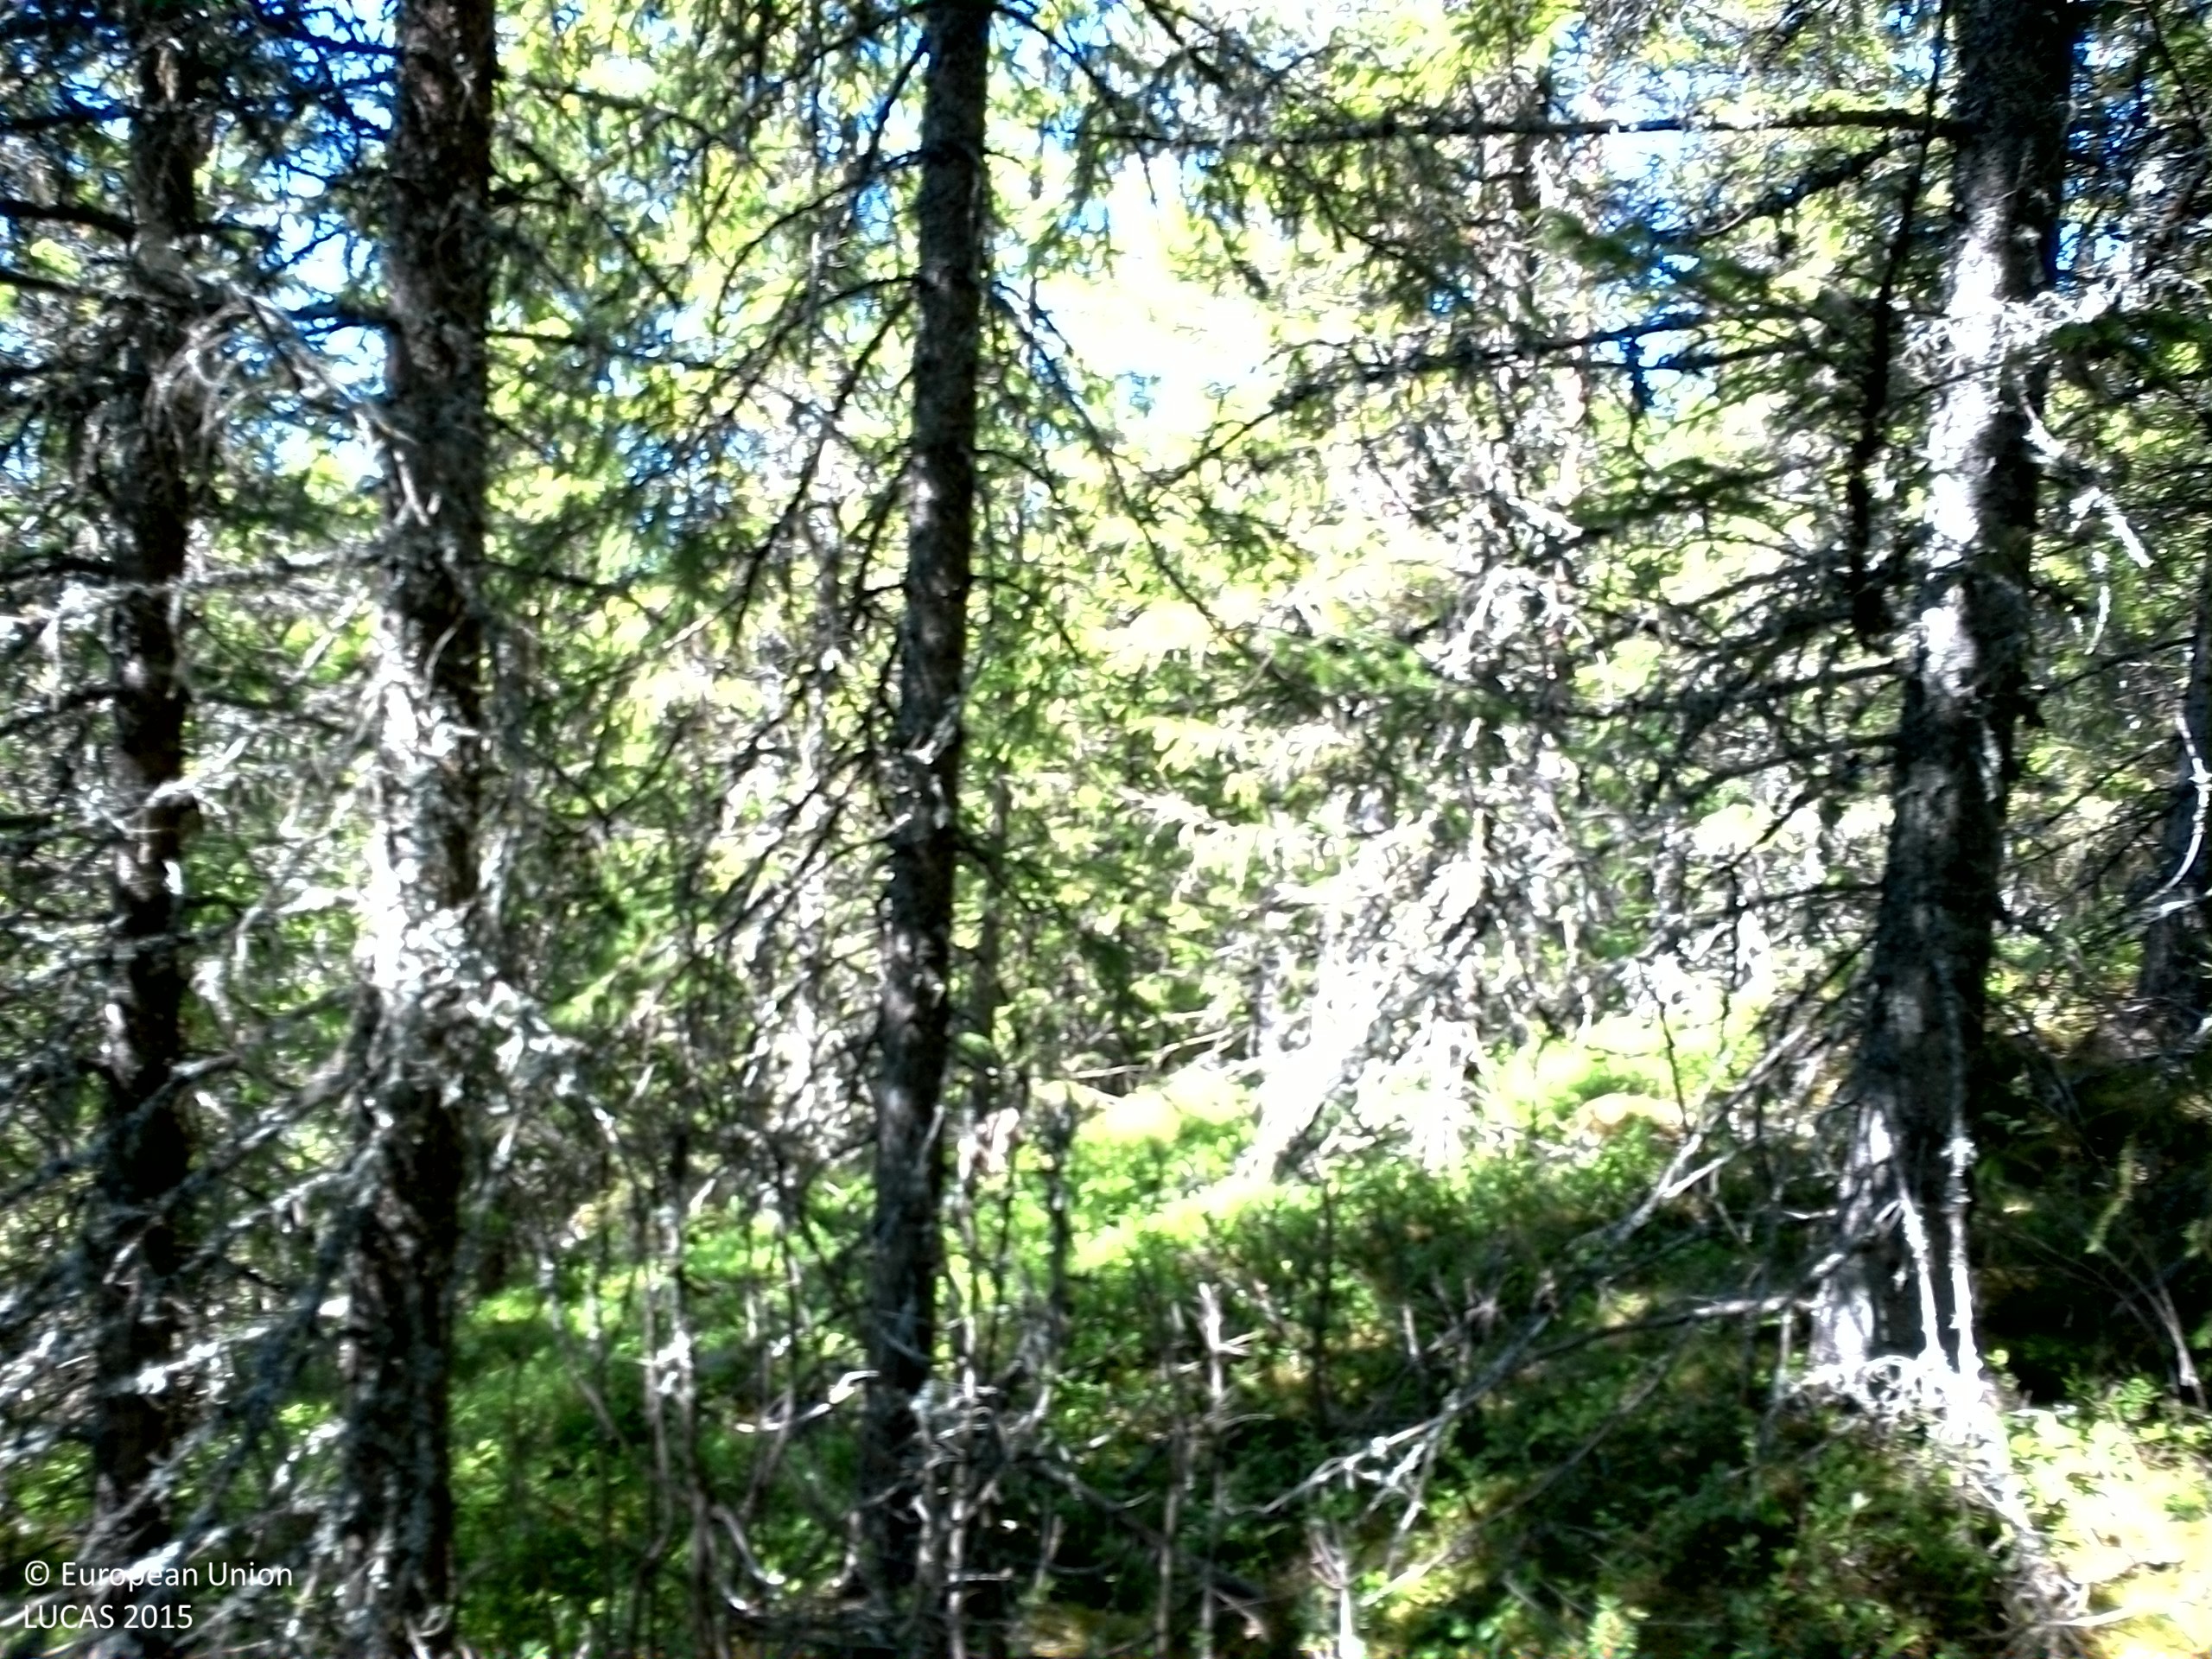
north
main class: Woodland
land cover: Spruce dominated coniferous woodland
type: boreal forest
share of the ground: 50 - 75 %
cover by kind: coniferous forest trees 70 %, shrubs 30 %
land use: Forestry
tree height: > 5 m
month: June
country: SE
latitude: 62.8325
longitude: 17.6936
